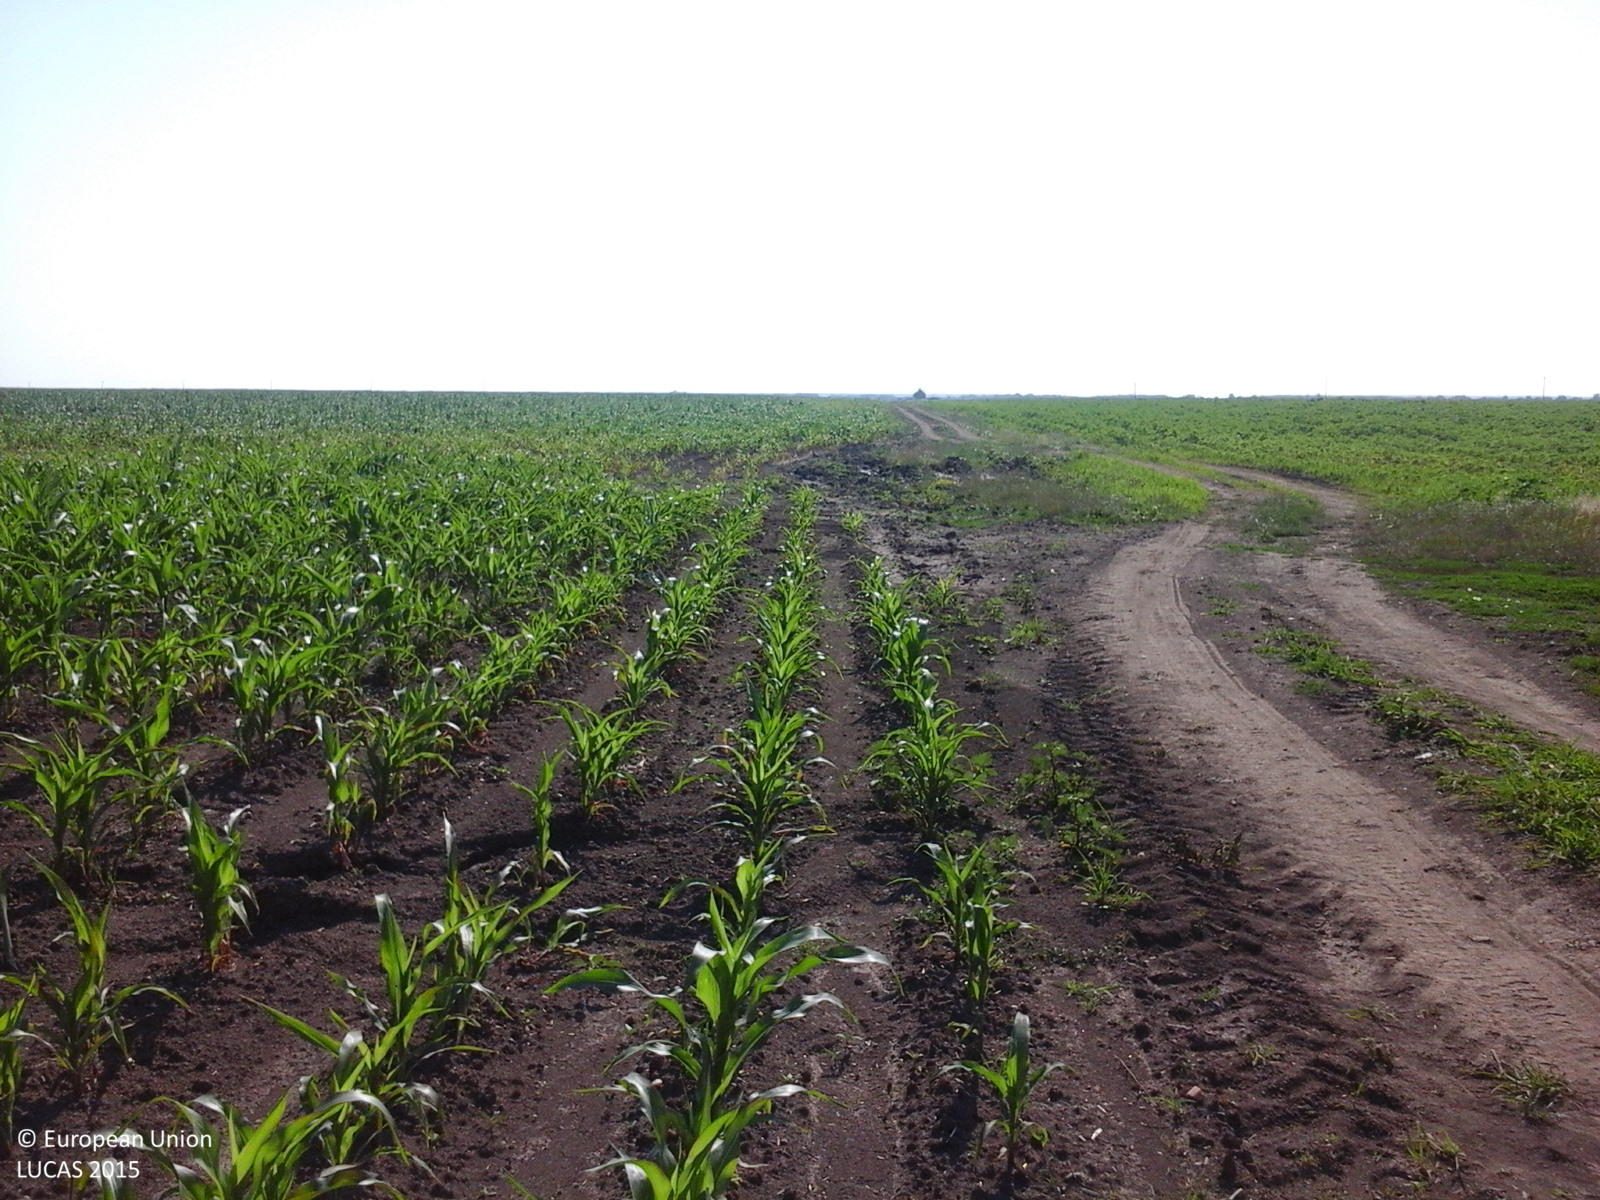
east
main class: Cropland
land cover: Maize
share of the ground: > 75 %
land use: Agriculture (excluding fallow land and kitchen gardens)
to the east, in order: Maize; Grassland with sparse tree/shrub cover; Maize
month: July
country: RO
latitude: 44.6492
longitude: 24.8446
